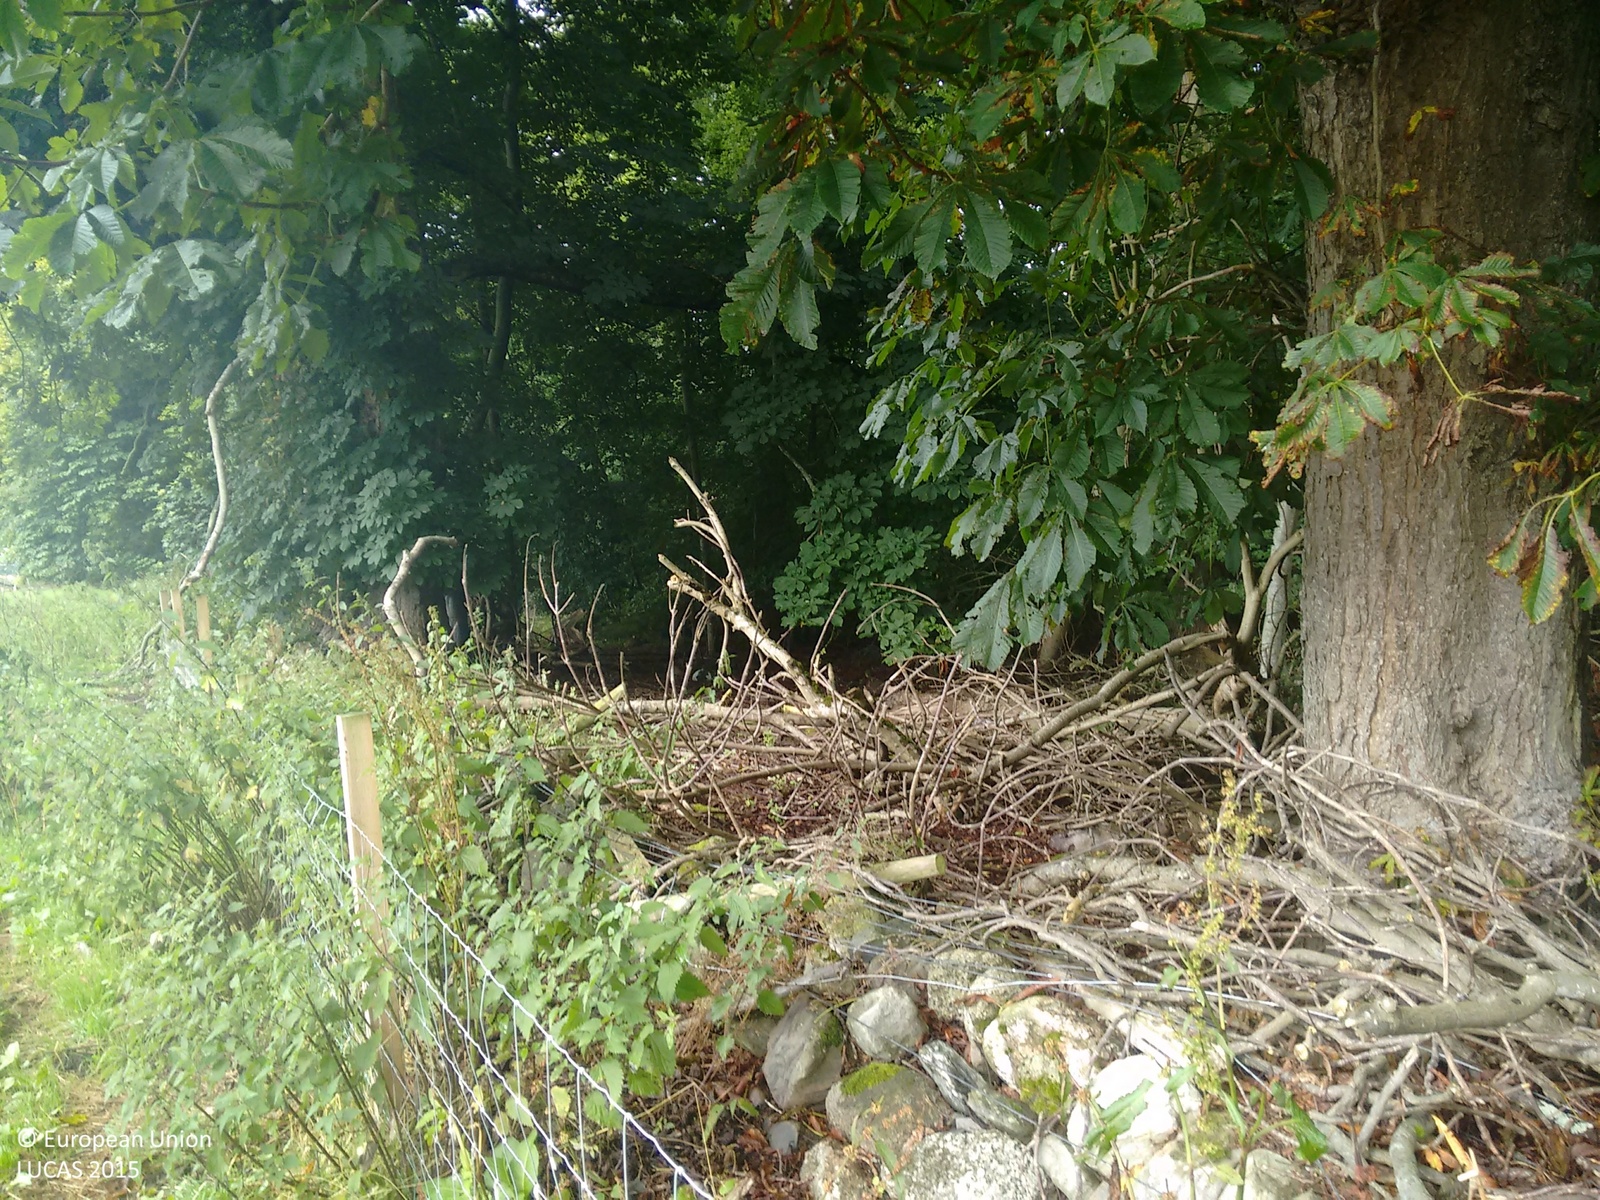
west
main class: Woodland
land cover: Broadleaved woodland
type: beech forest
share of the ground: > 75 %
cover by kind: broadleaved forest trees 100 %
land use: Forestry
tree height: > 5 m
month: August
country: GB
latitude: 57.7726
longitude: -4.0169
